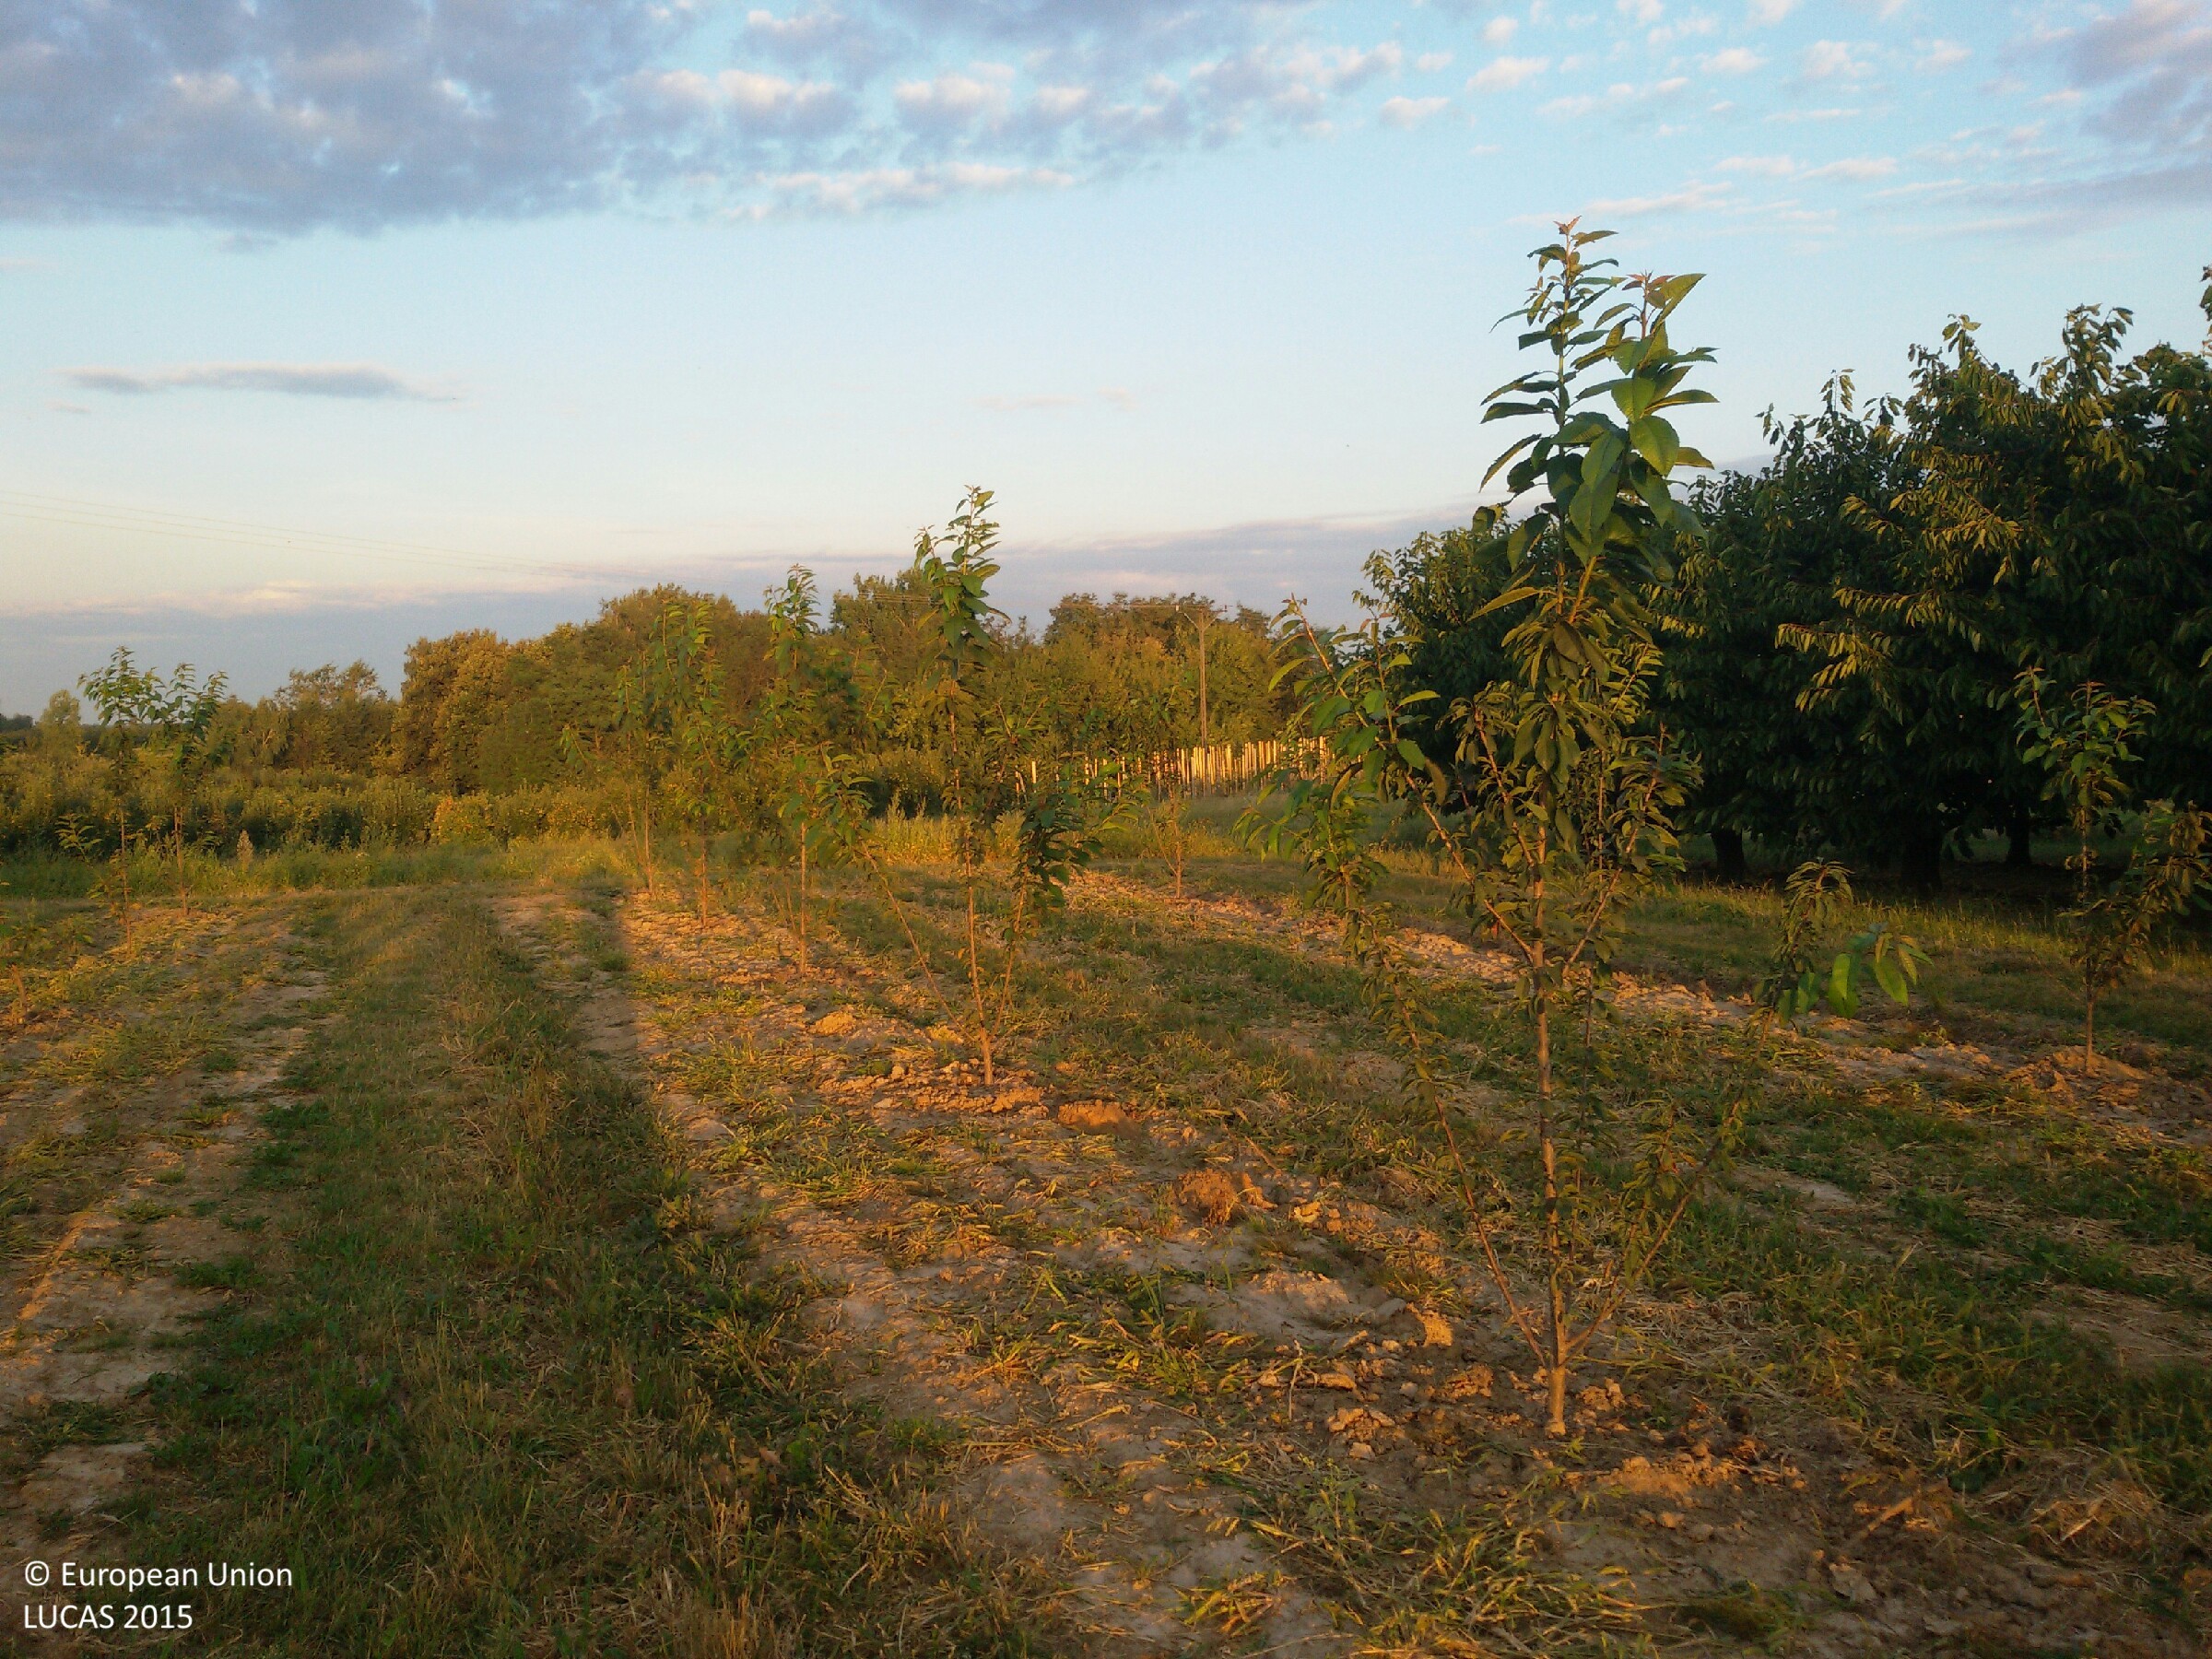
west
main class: Cropland
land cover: Cherry fruit
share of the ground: 50 - 75 %
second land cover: Grassland without tree/shrub cover
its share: > 75 %
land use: Agriculture (excluding fallow land and kitchen gardens)
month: August
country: PL
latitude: 50.7231
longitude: 21.7120
